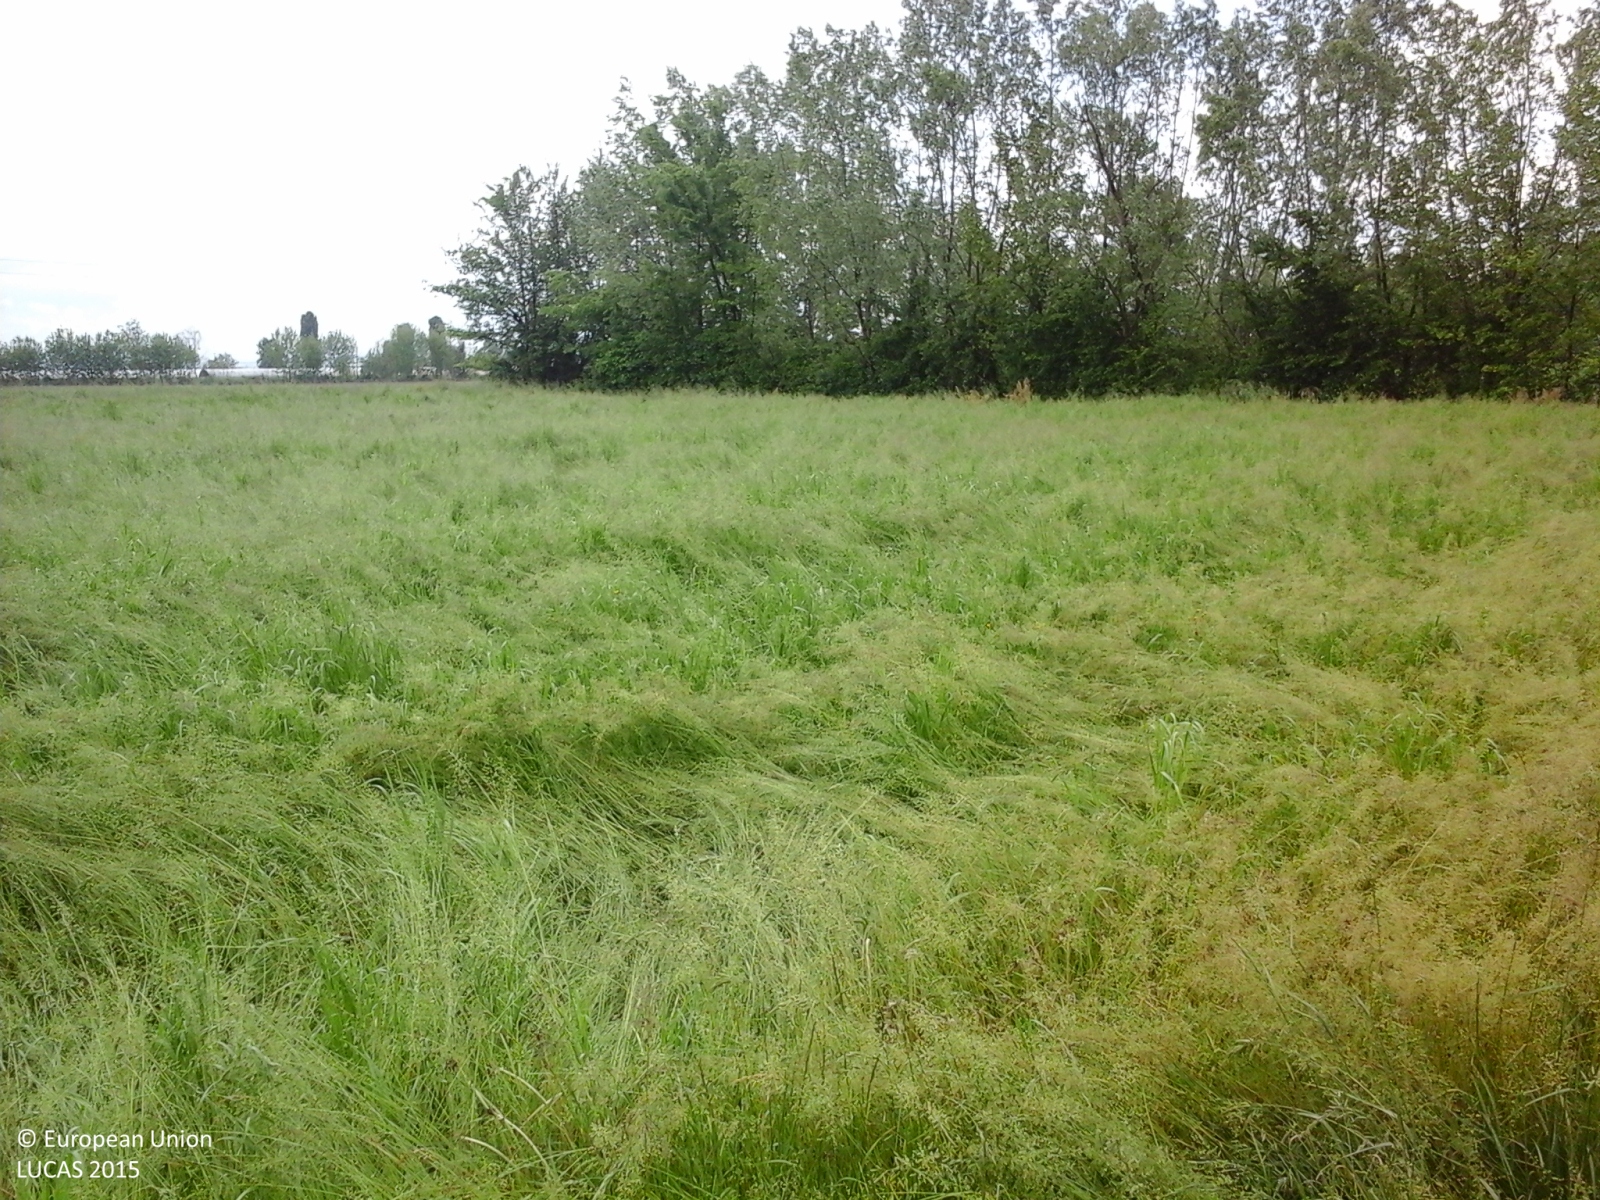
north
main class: Cropland
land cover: Maize
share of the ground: < 10 %
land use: Agriculture (excluding fallow land and kitchen gardens)
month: April
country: IT
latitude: 45.2863
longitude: 10.6236
